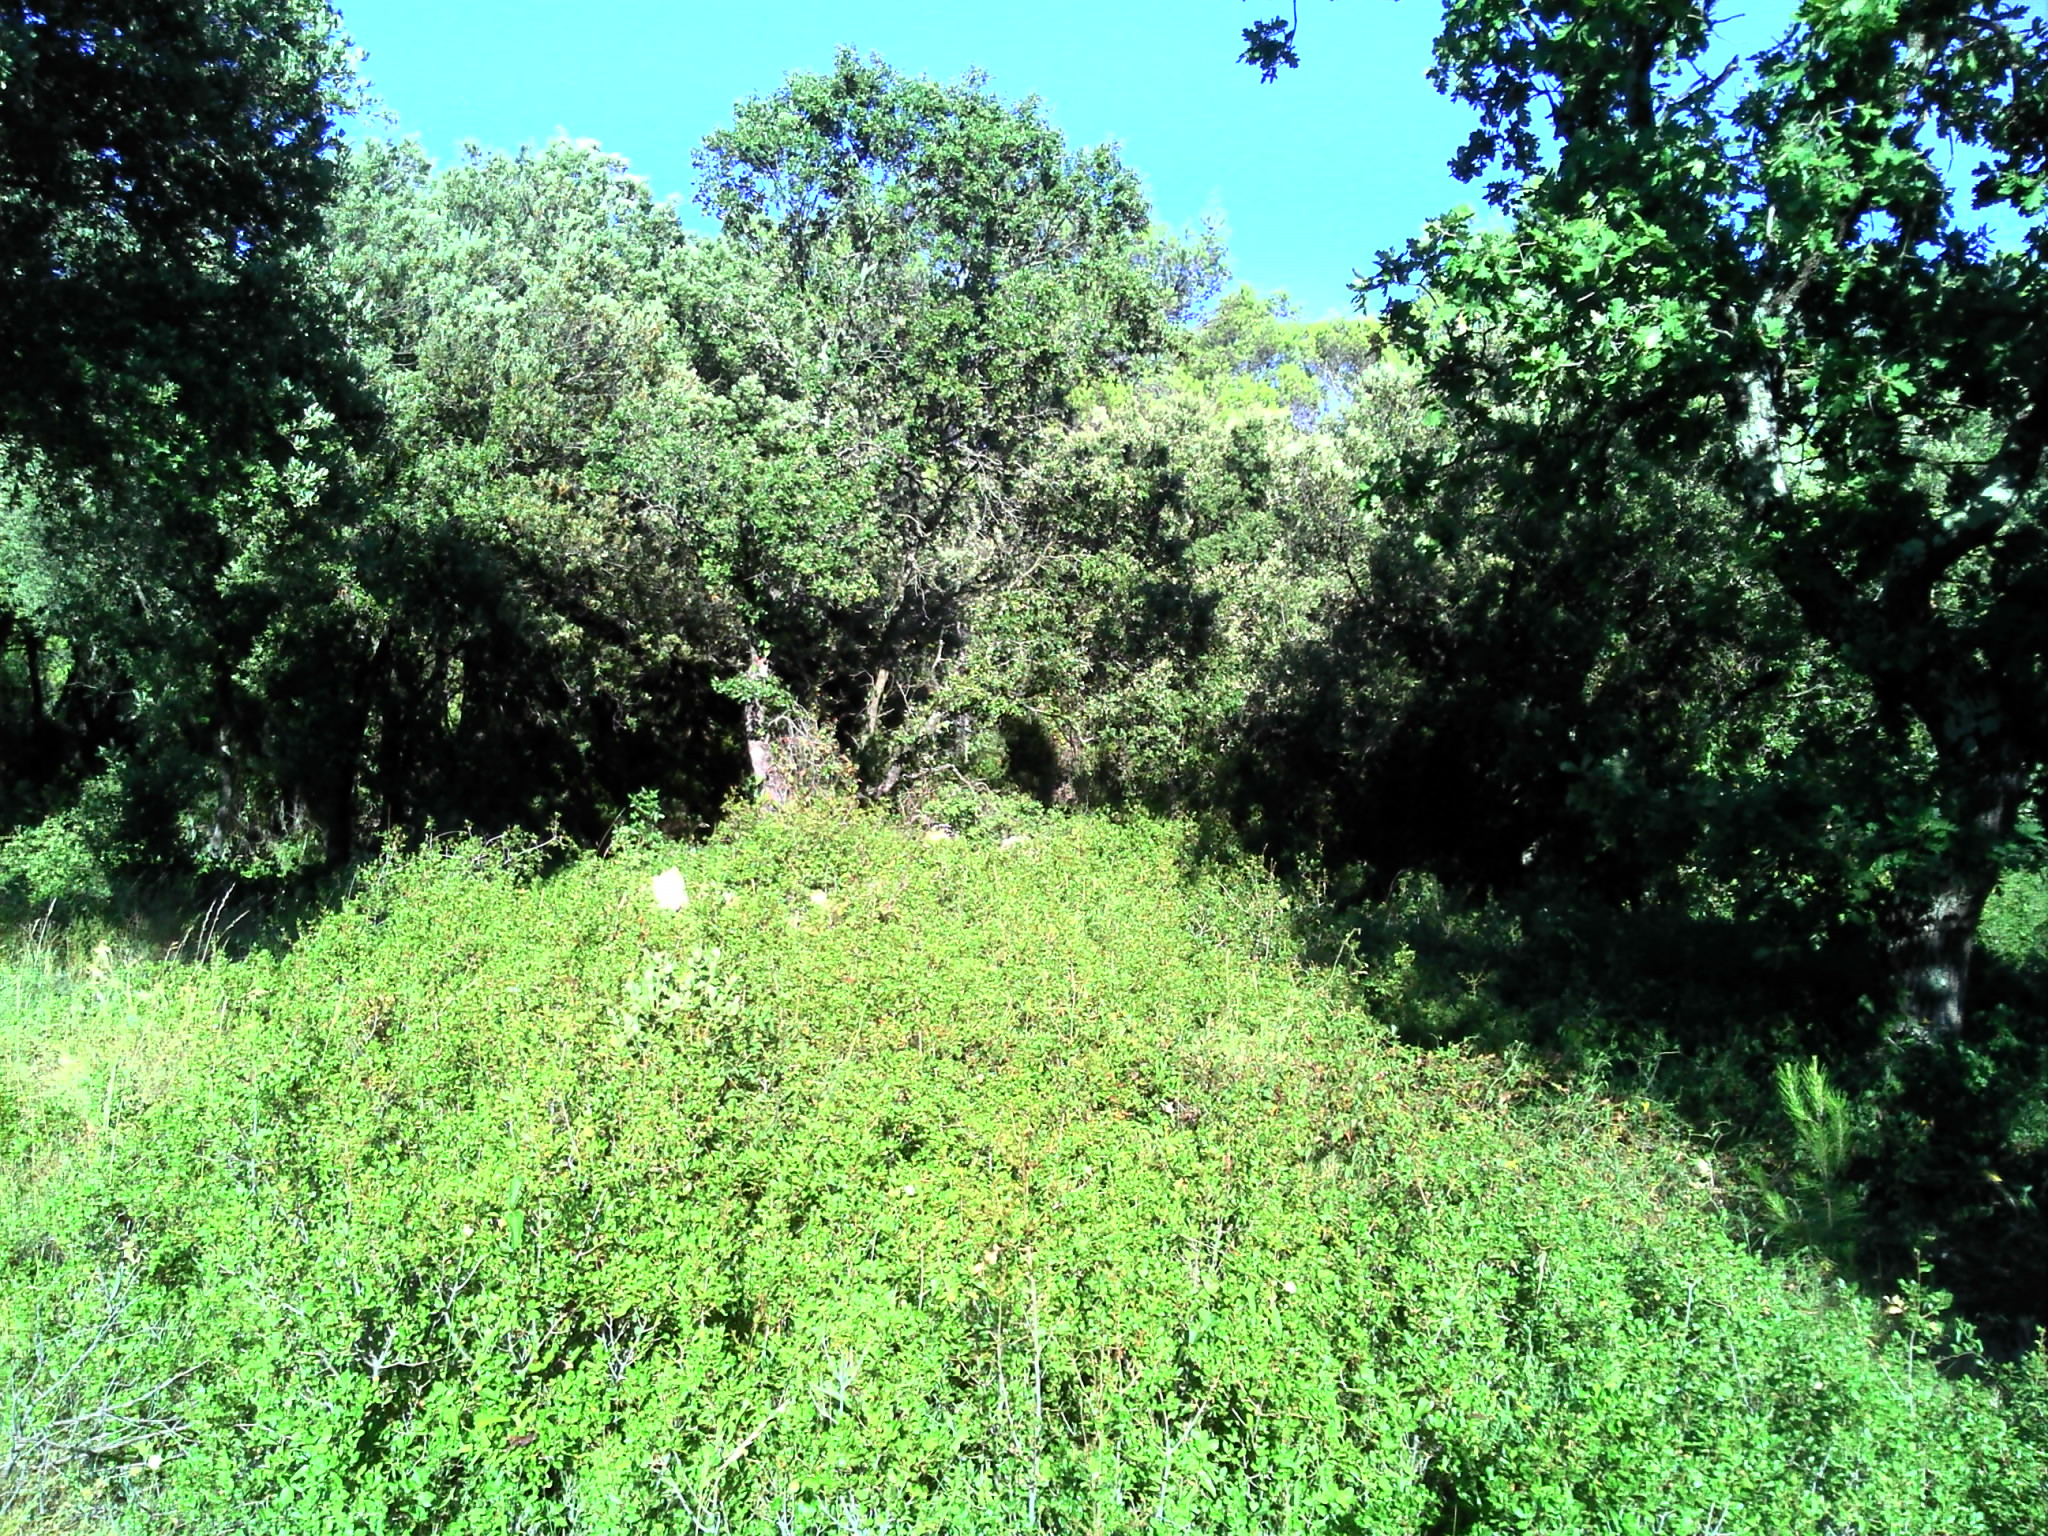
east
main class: Woodland
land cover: Broadleaved woodland
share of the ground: > 75 %
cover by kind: broadleaved forest trees 40 %, shrubs 40 %, herbaceous plants 15 %, consolidated bare surface 5 %
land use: Semi-natural and natural areas not in use
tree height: < 5 m
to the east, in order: Broadleaved woodland; Pine dominated coniferous woodland; Pine dominated mixed woodland; Tracks; Shrubland without tree cover; Broadleaved woodland
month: July
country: FR
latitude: 44.0135
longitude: 4.3076
